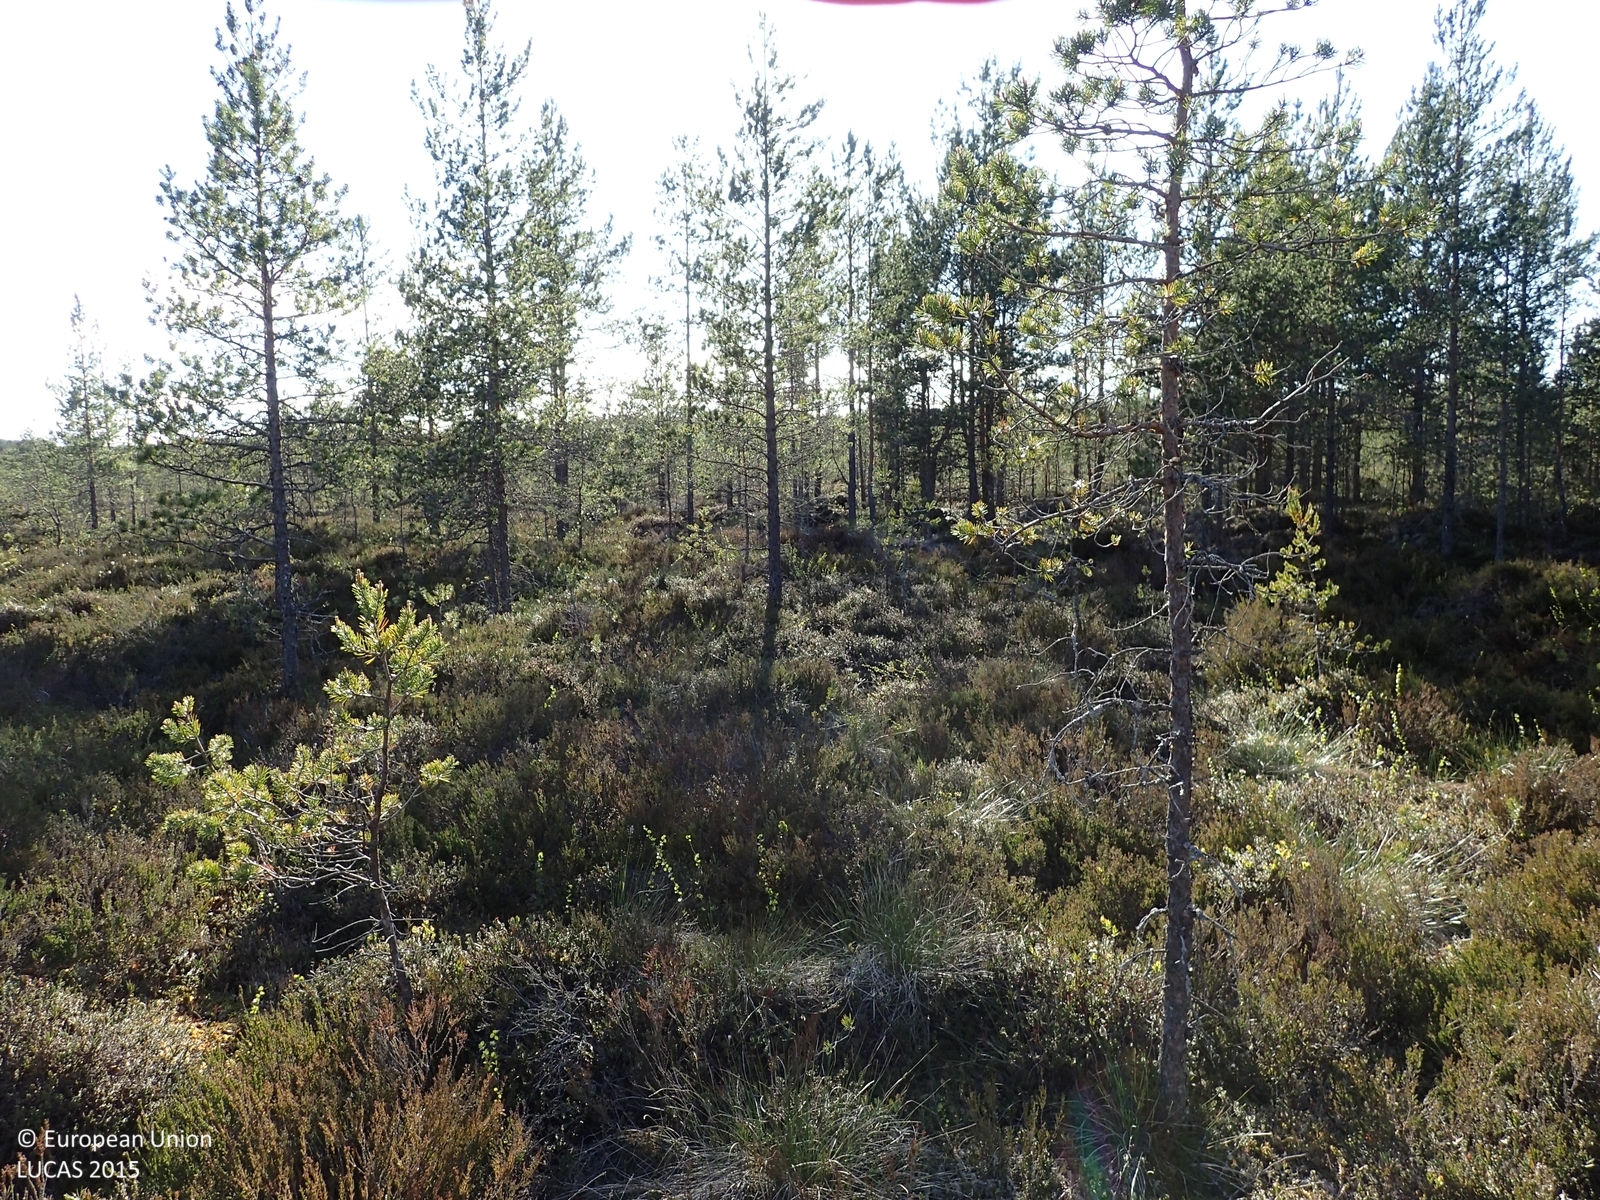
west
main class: Woodland
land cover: Pine dominated coniferous woodland
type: boreal forest
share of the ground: 50 - 75 %
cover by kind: coniferous forest trees 50 %, shrubs 50 %
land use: Forestry
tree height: > 5 m
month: June
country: FI
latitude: 62.2050
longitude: 21.7553
